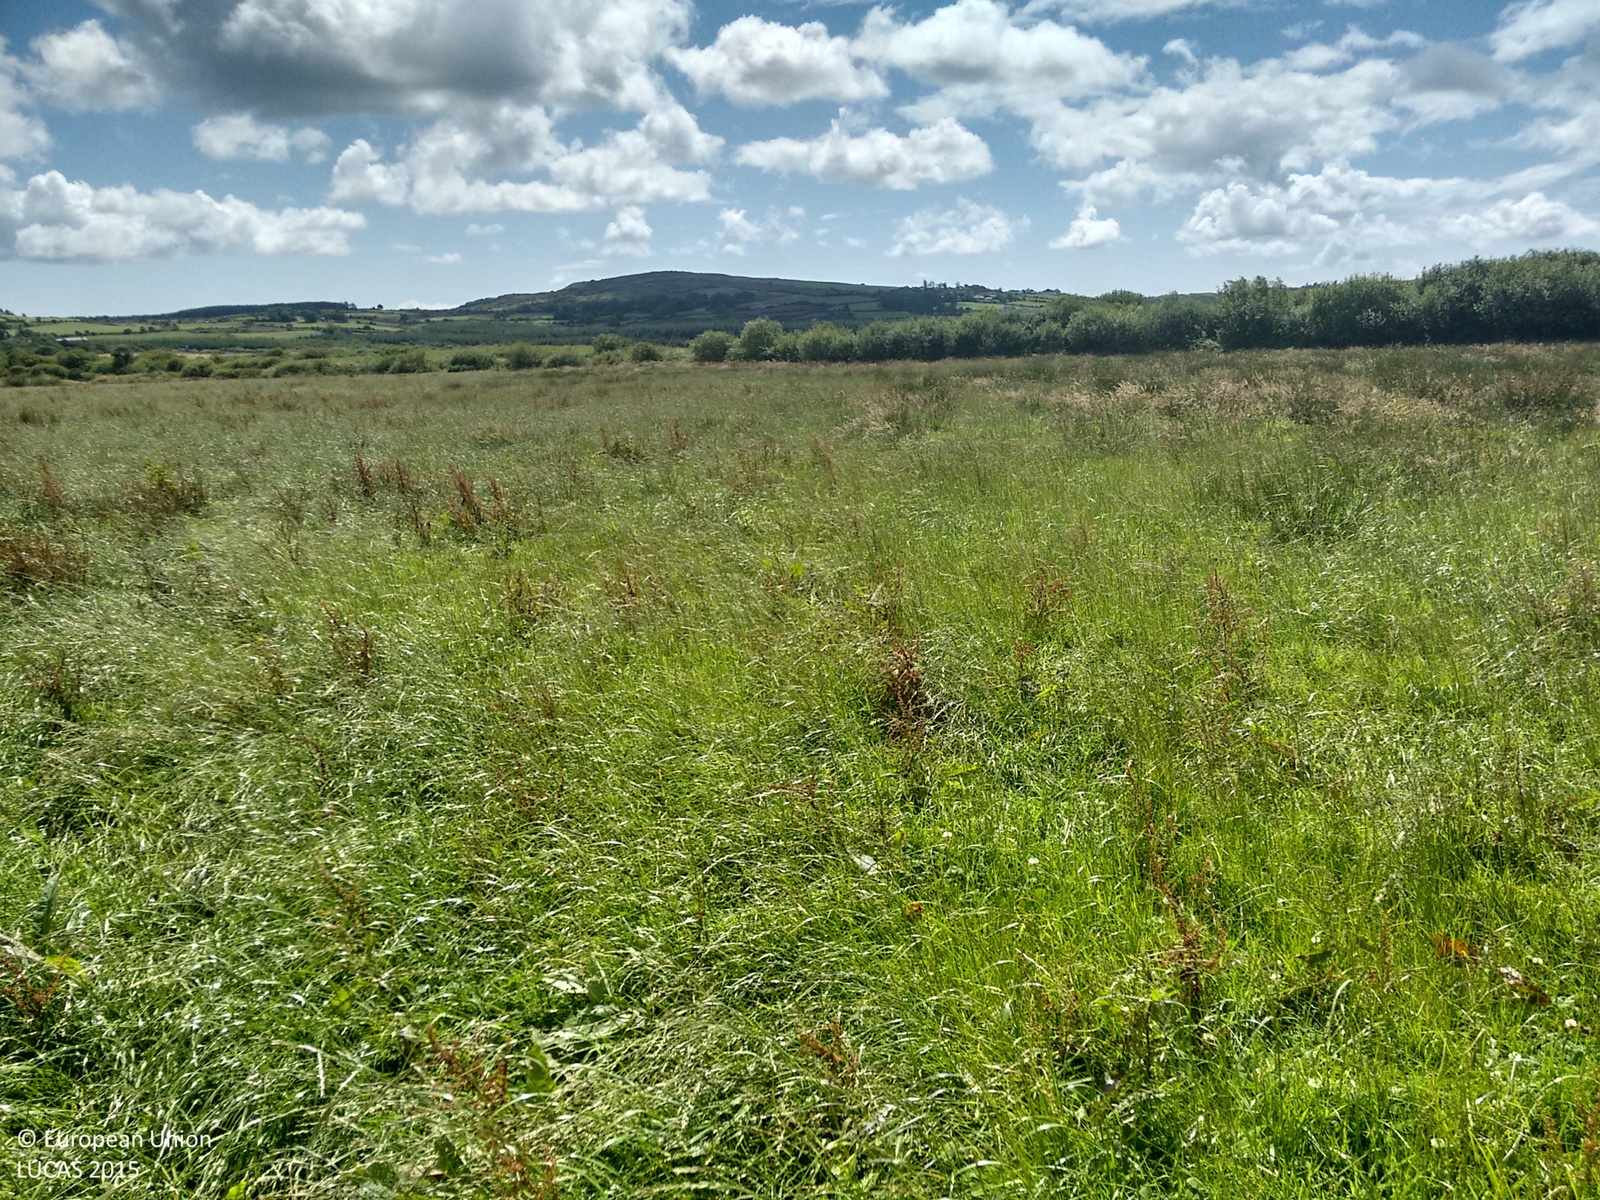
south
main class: Grassland
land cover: Grassland without tree/shrub cover
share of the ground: > 75 %
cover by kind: herbaceous plants 100 %
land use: Agriculture (excluding fallow land and kitchen gardens)
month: July
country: IE
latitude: 51.6278
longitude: -9.1578
